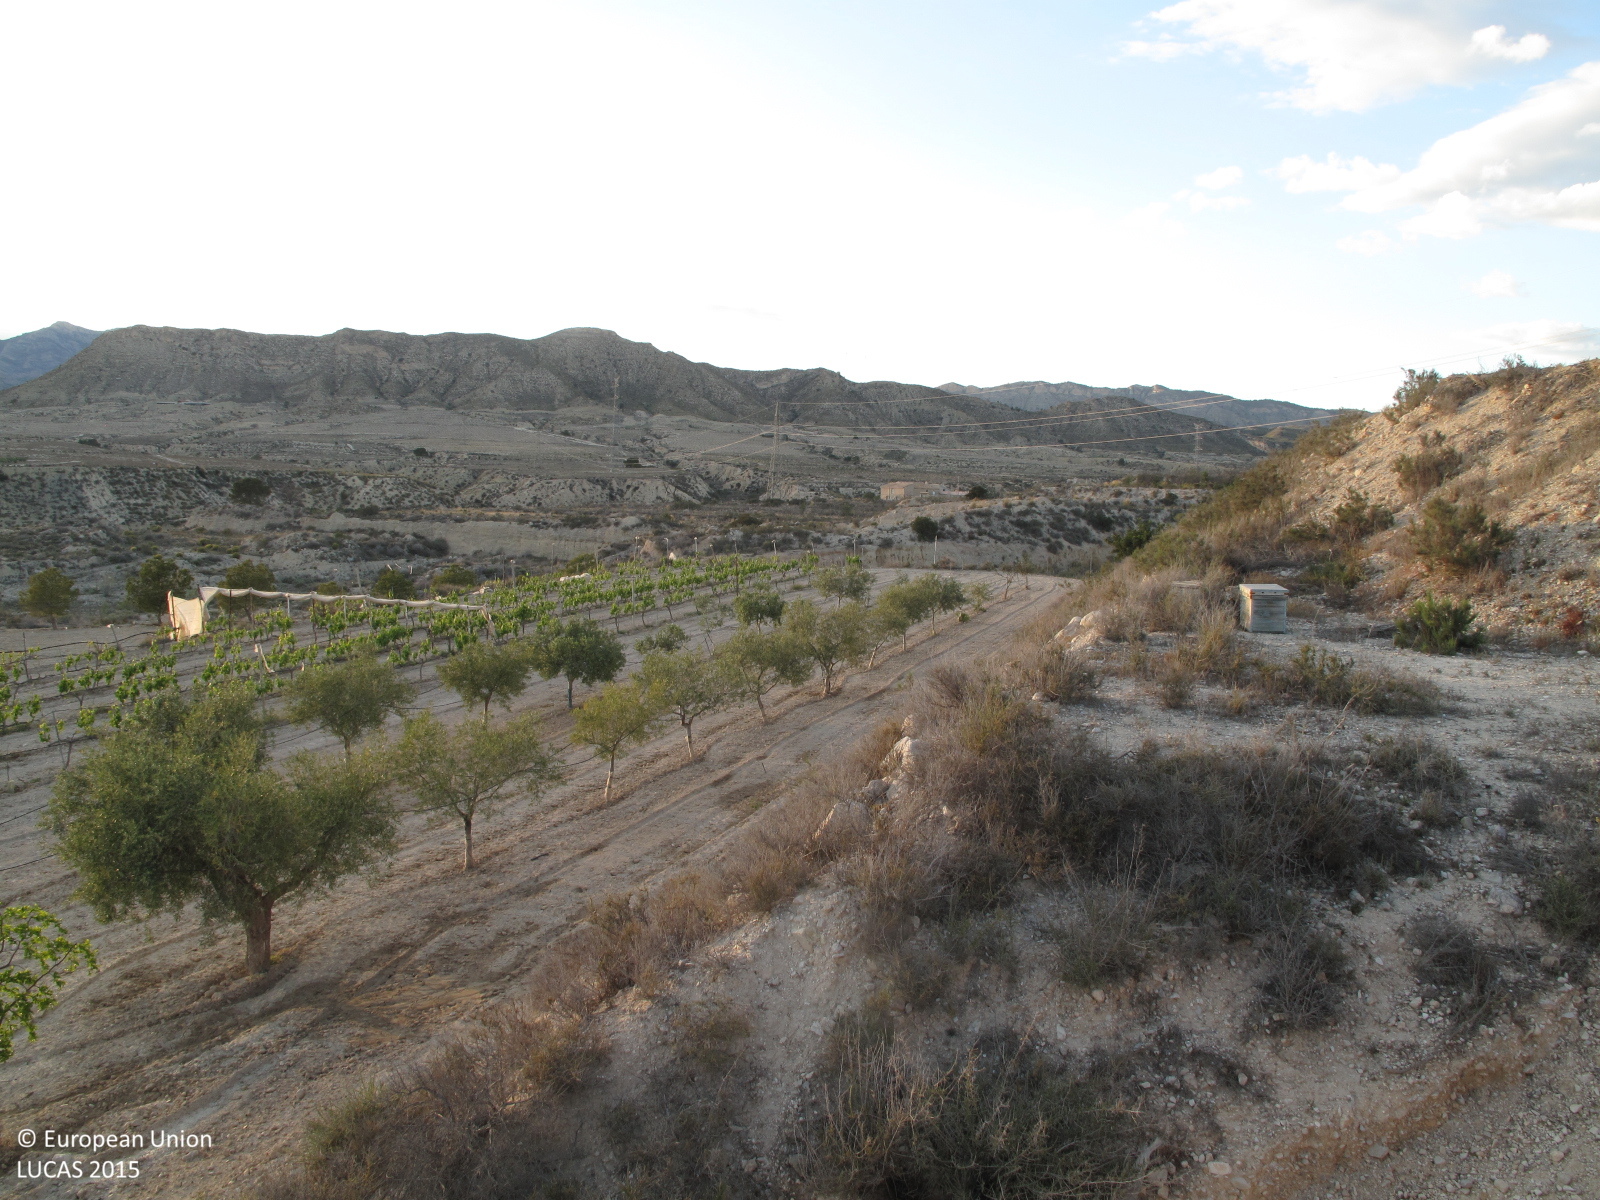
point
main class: Cropland
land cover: Olive groves
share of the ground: 10 - 25 %
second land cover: Other bare soil
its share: > 75 %
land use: Agriculture (excluding fallow land and kitchen gardens)
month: April
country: ES
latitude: 38.4850
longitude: -0.4535
